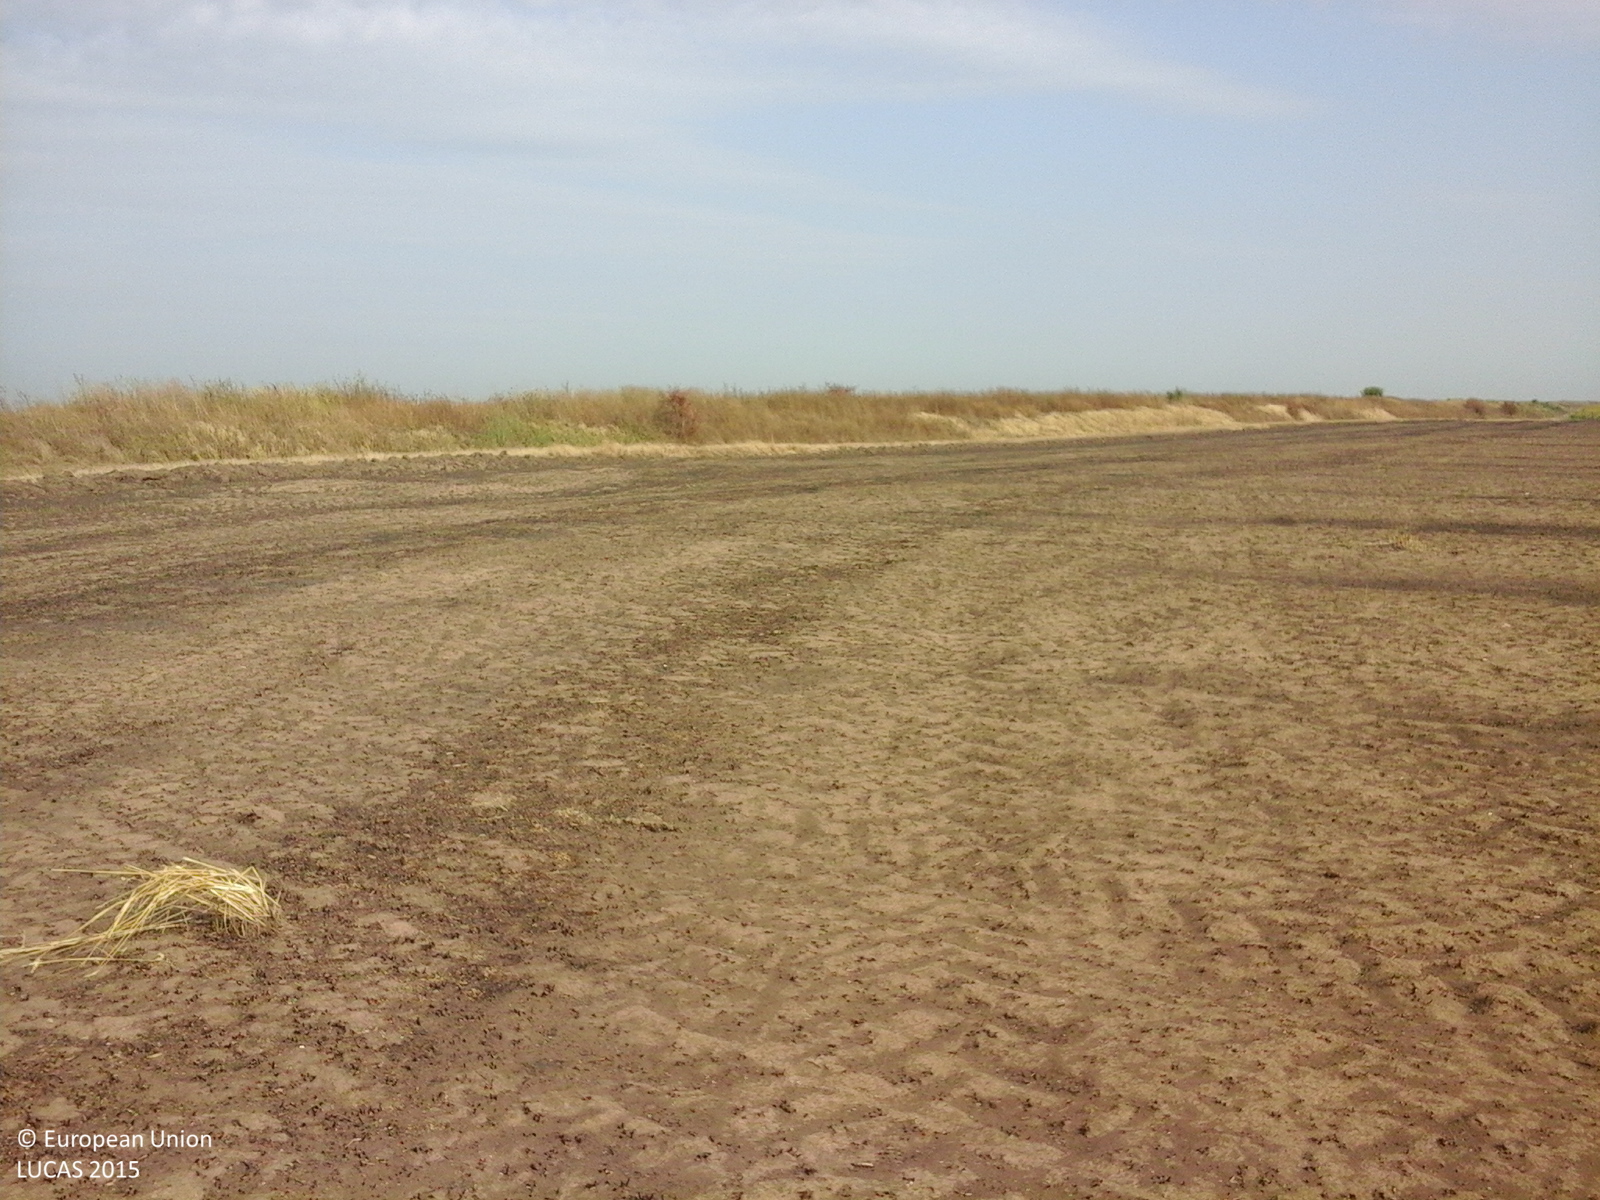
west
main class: Cropland
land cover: Common wheat
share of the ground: < 10 %
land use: Agriculture (excluding fallow land and kitchen gardens)
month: August
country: RO
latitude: 43.8488
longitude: 28.4112
